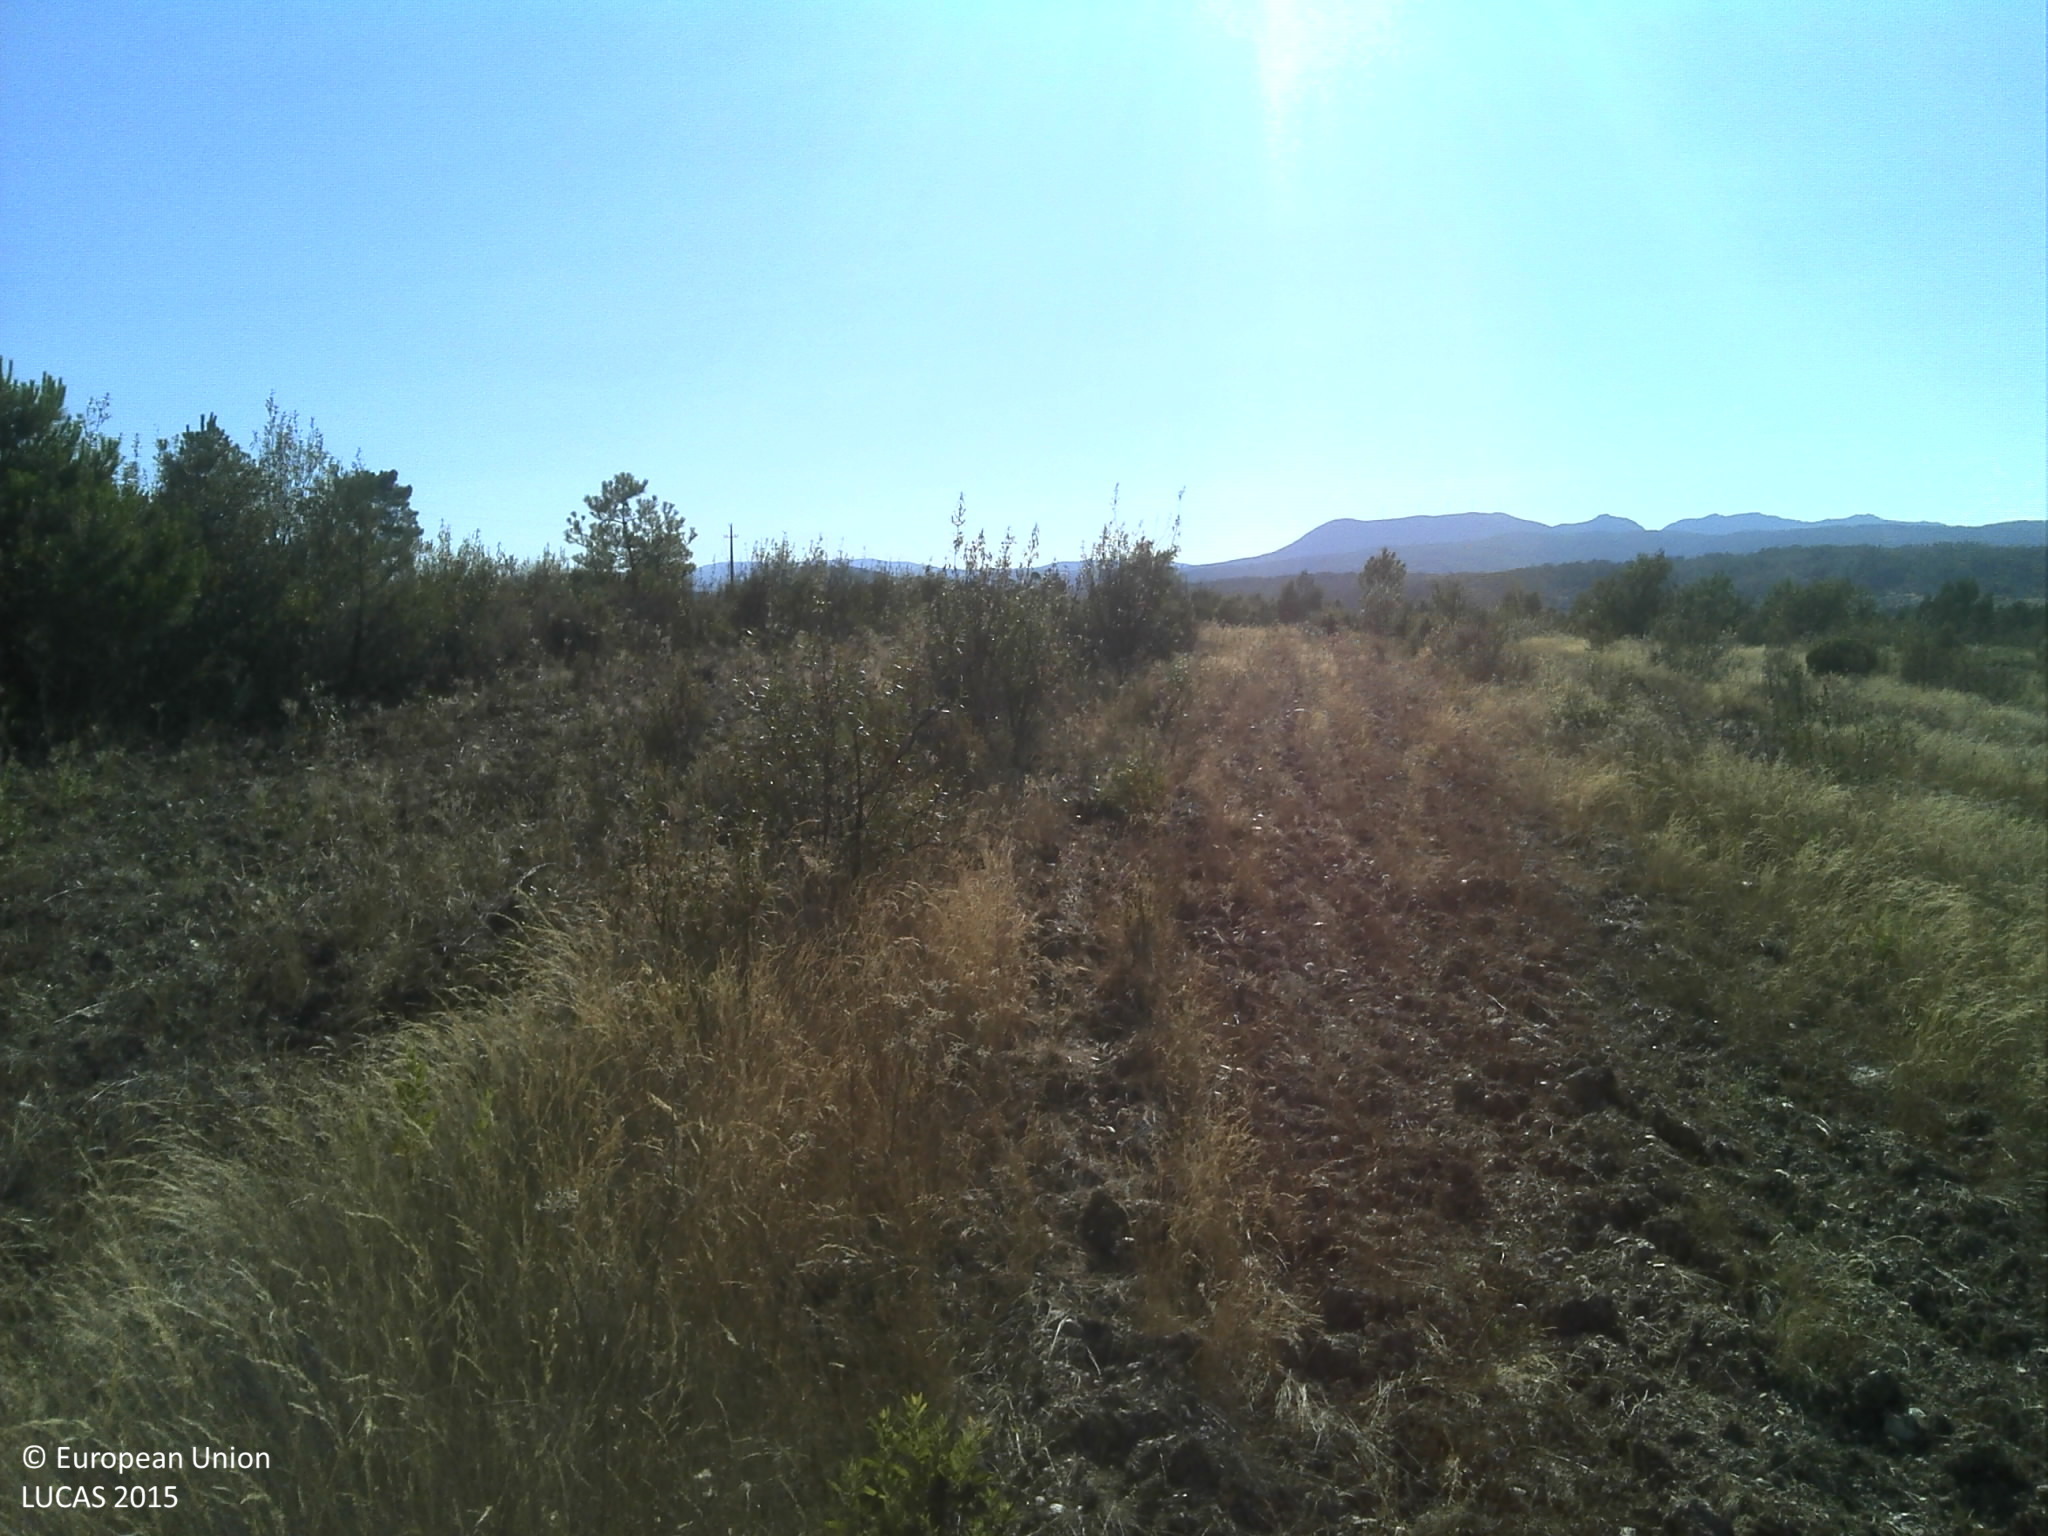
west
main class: Grassland
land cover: Grassland with sparse tree/shrub cover
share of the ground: 25 - 50 %
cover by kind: unconsolidated bare surface 70 %, herbaceous plants 25 %, broadleaved forest trees 5 %
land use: Forestry
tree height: < 5 m
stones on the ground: 10 - 25 %
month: July
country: PT
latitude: 39.9012
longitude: -7.5889
